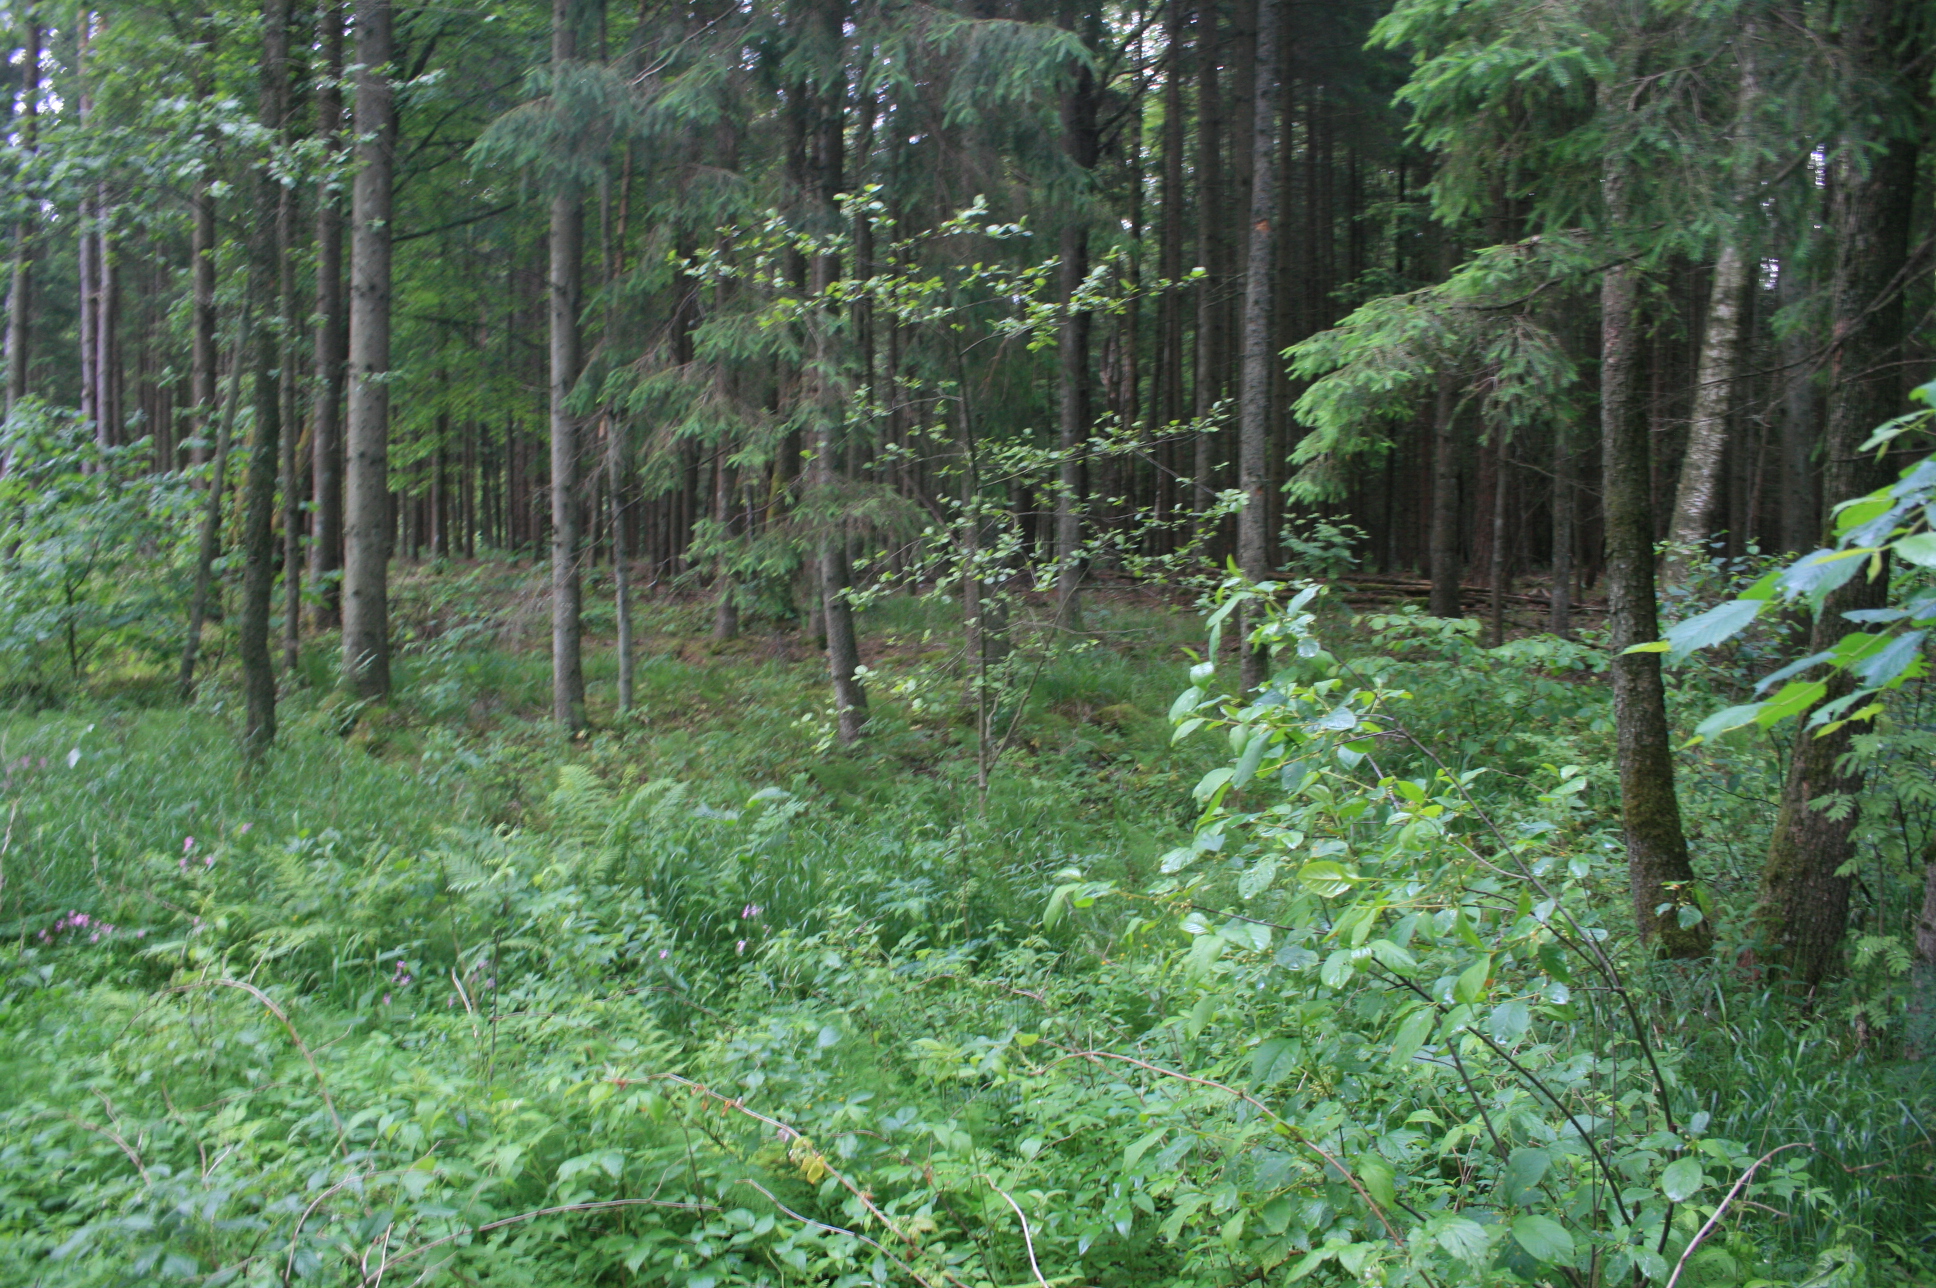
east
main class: Woodland
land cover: Spruce dominated mixed woodland
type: hemiboreal forest and nemoral coniferous forest and mixed broadleaved-coniferous forest
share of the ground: 50 - 75 %
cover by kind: coniferous forest trees 50 %, herbaceous plants 30 %, broadleaved forest trees 20 %
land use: Forestry
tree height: > 5 m
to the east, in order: Spruce dominated mixed woodland; Broadleaved woodland; Ditches and canals; Broadleaved woodland; Spruce dominated coniferous woodland
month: June
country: LT
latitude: 55.3527
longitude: 22.1529
